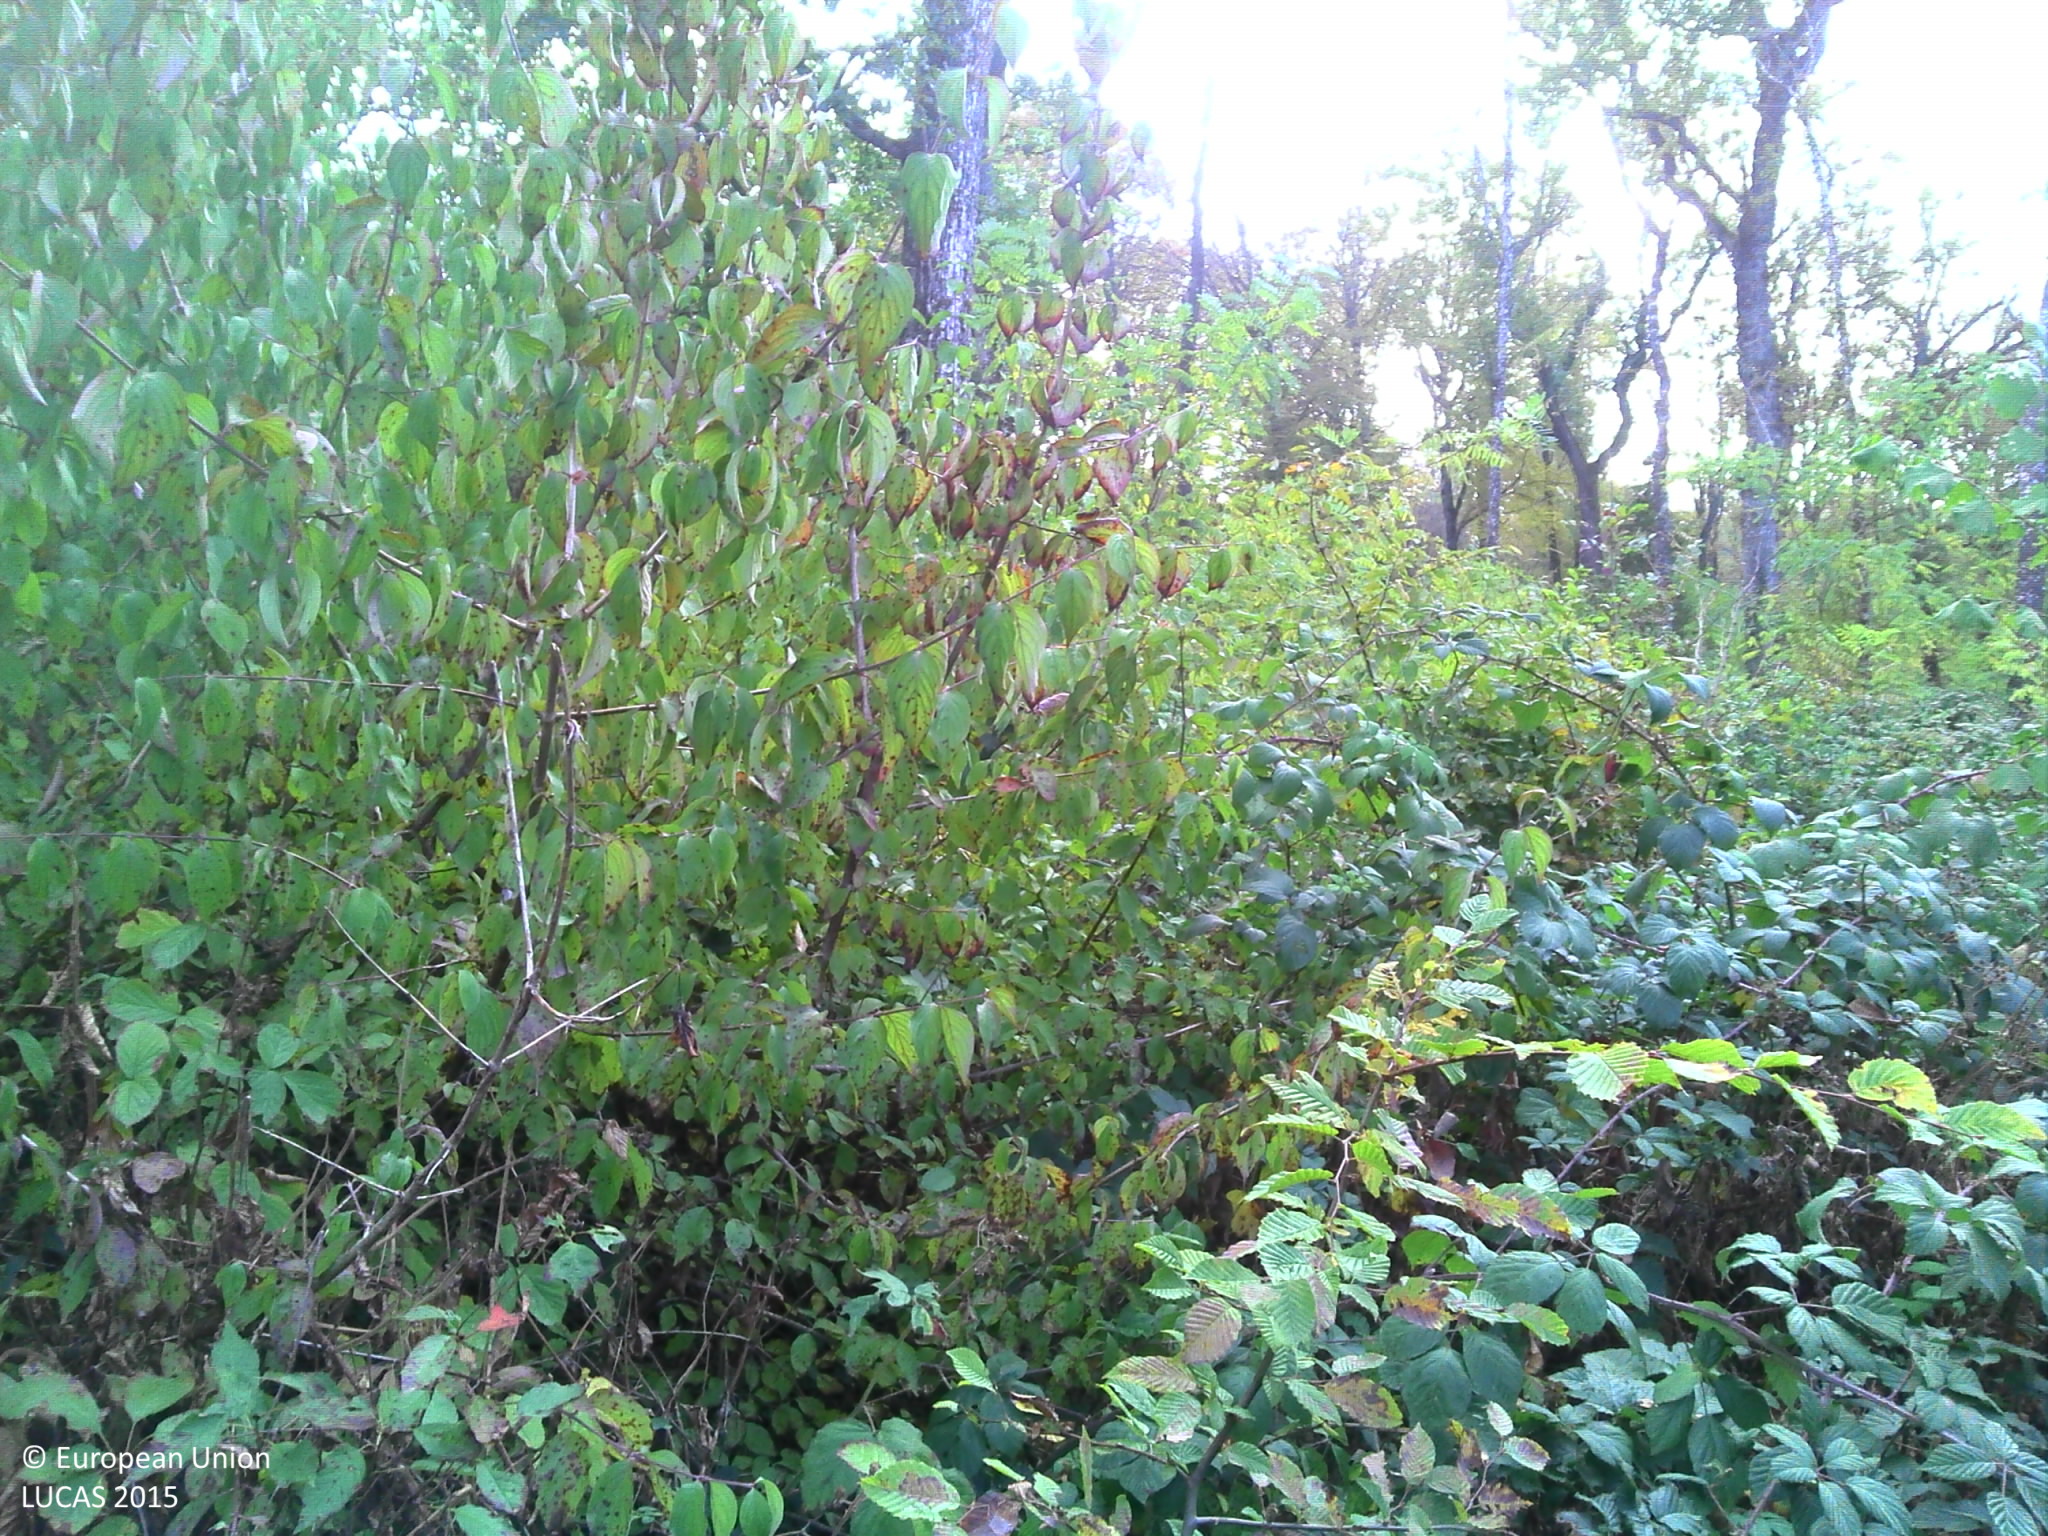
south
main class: Woodland
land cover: Broadleaved woodland
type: mesophytic deciduous forest
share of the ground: > 75 %
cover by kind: broadleaved forest trees 100 %
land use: Forestry
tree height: > 5 m
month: October
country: FR
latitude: 47.5626
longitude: 5.2555
